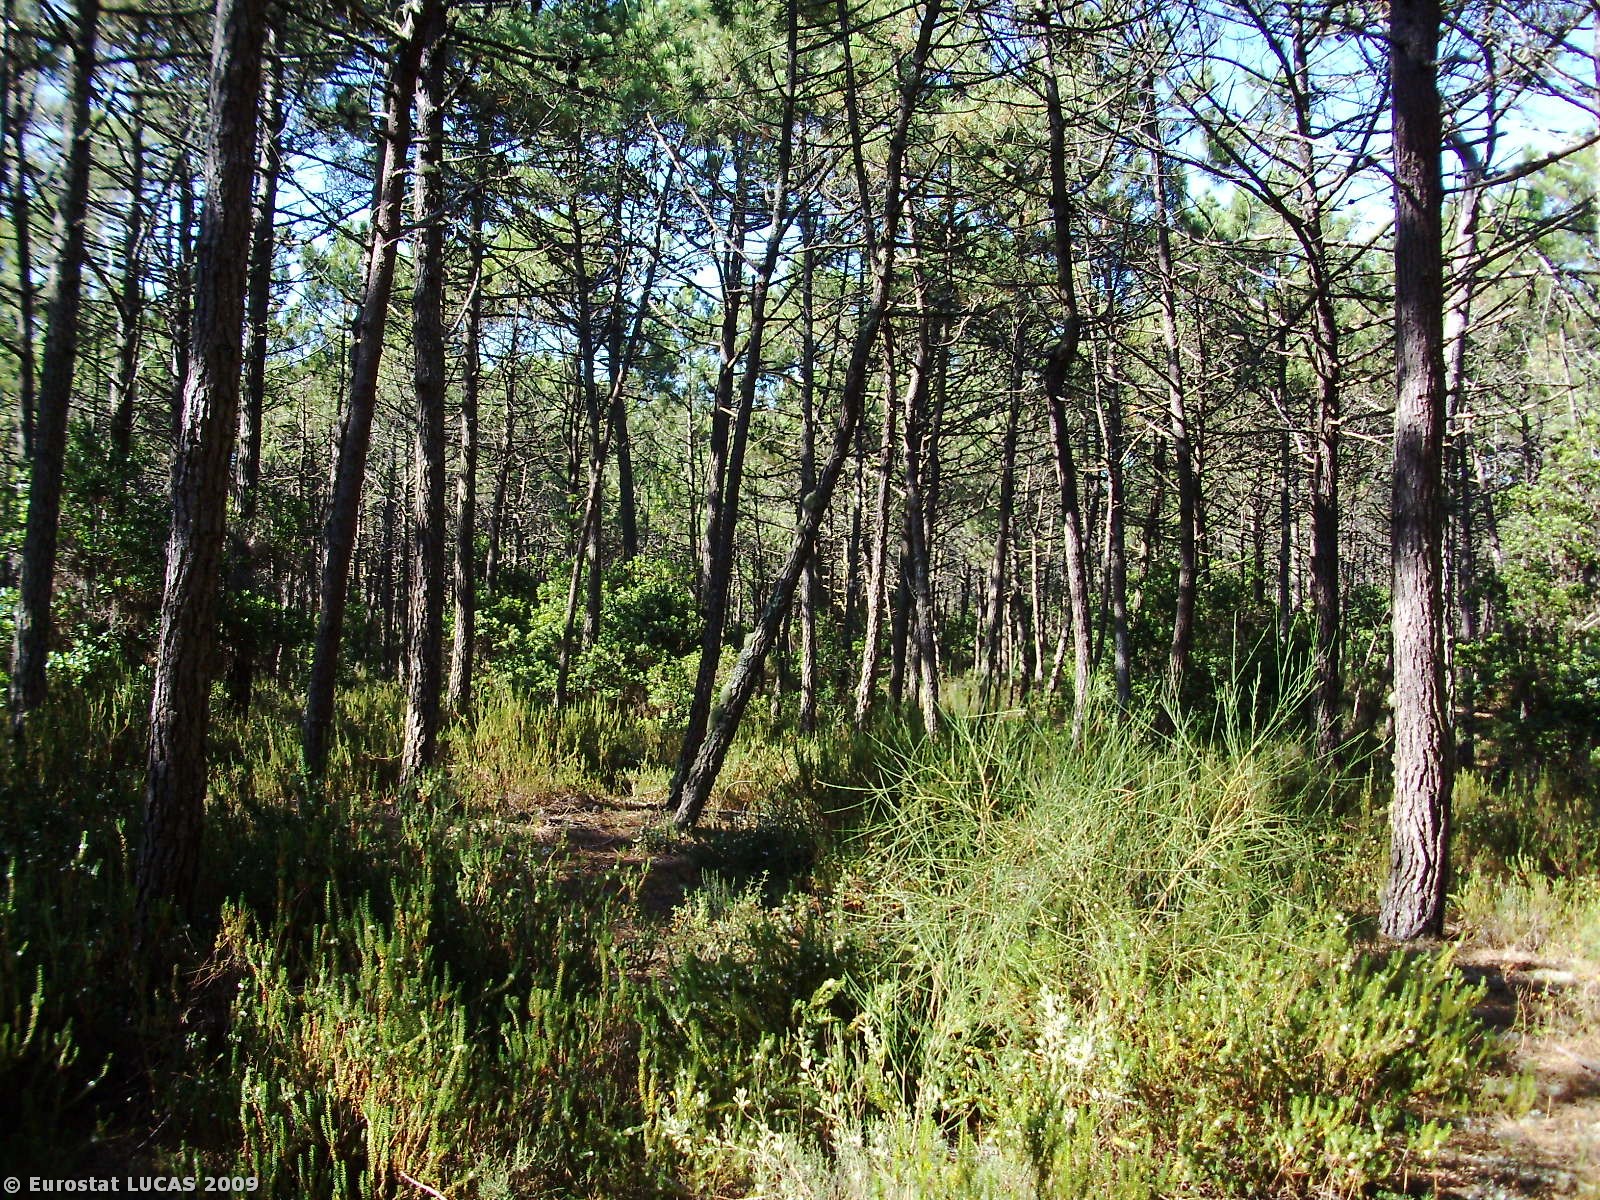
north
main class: Woodland
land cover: Coniferous woodland
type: coniferous forest of the mediterranean region
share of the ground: > 75 %
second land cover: Shrubland with sparse tree cover
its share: 10 - 25 %
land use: Forestry
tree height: > 5 m
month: August
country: PT
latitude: 39.9042
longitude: -8.9364
